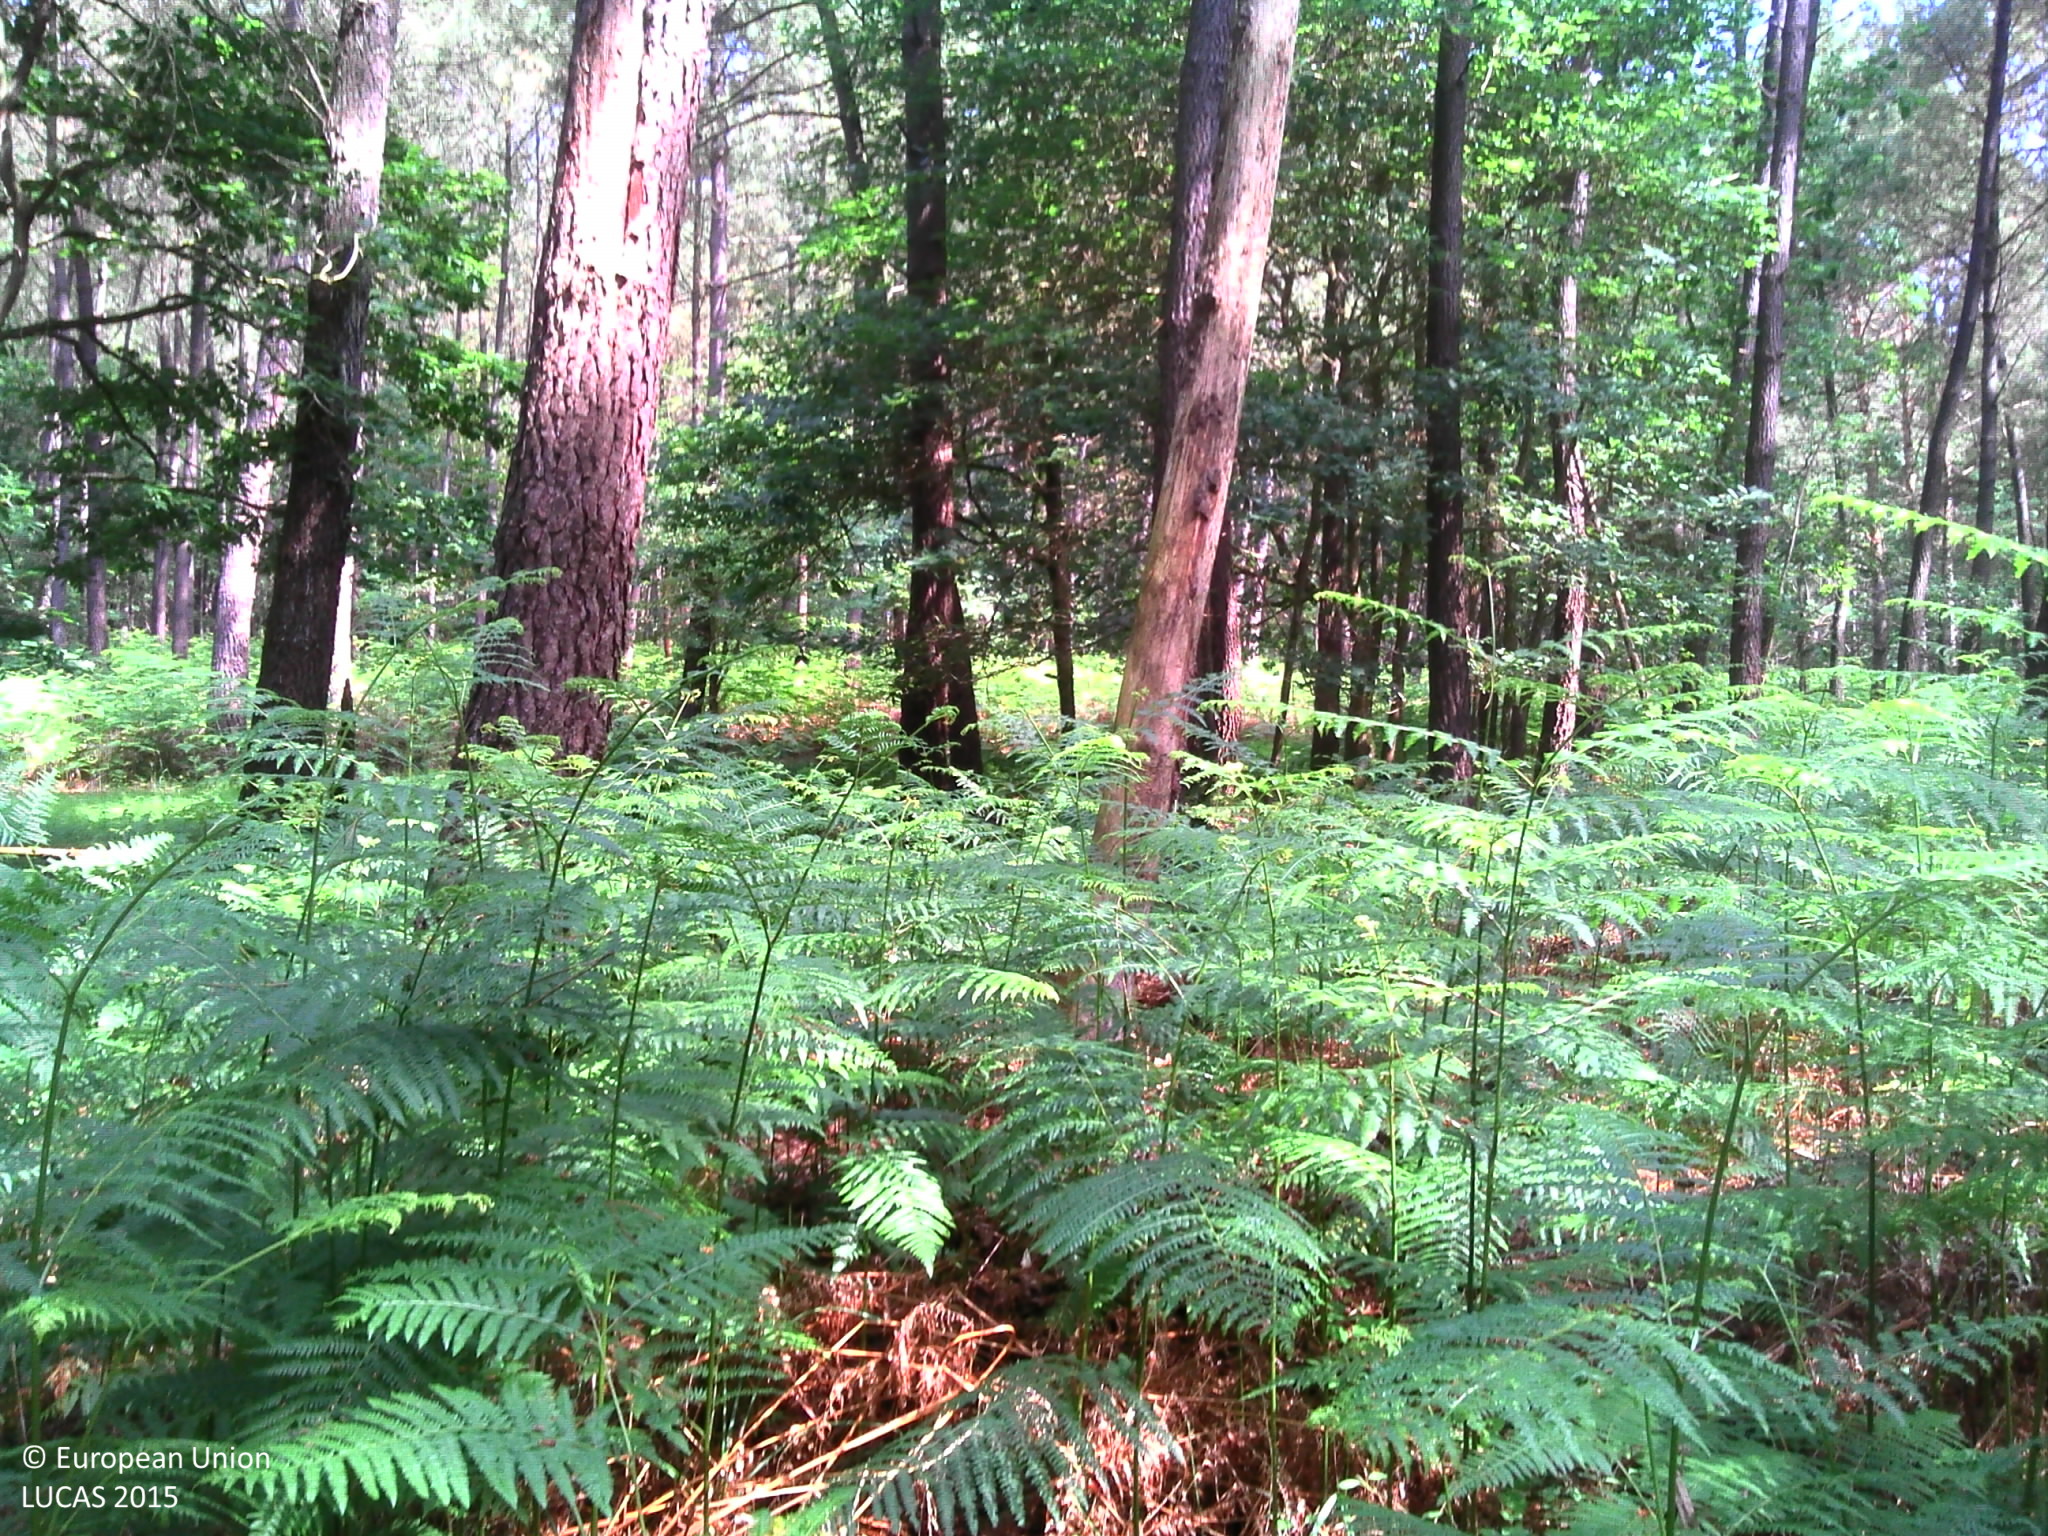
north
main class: Woodland
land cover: Pine dominated coniferous woodland
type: exotic forest
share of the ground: > 75 %
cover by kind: coniferous forest trees 70 %, broadleaved forest trees 15 %, herbaceous plants 15 %
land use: Forestry
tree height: > 5 m
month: June
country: FR
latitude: 47.1354
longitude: 1.0585
